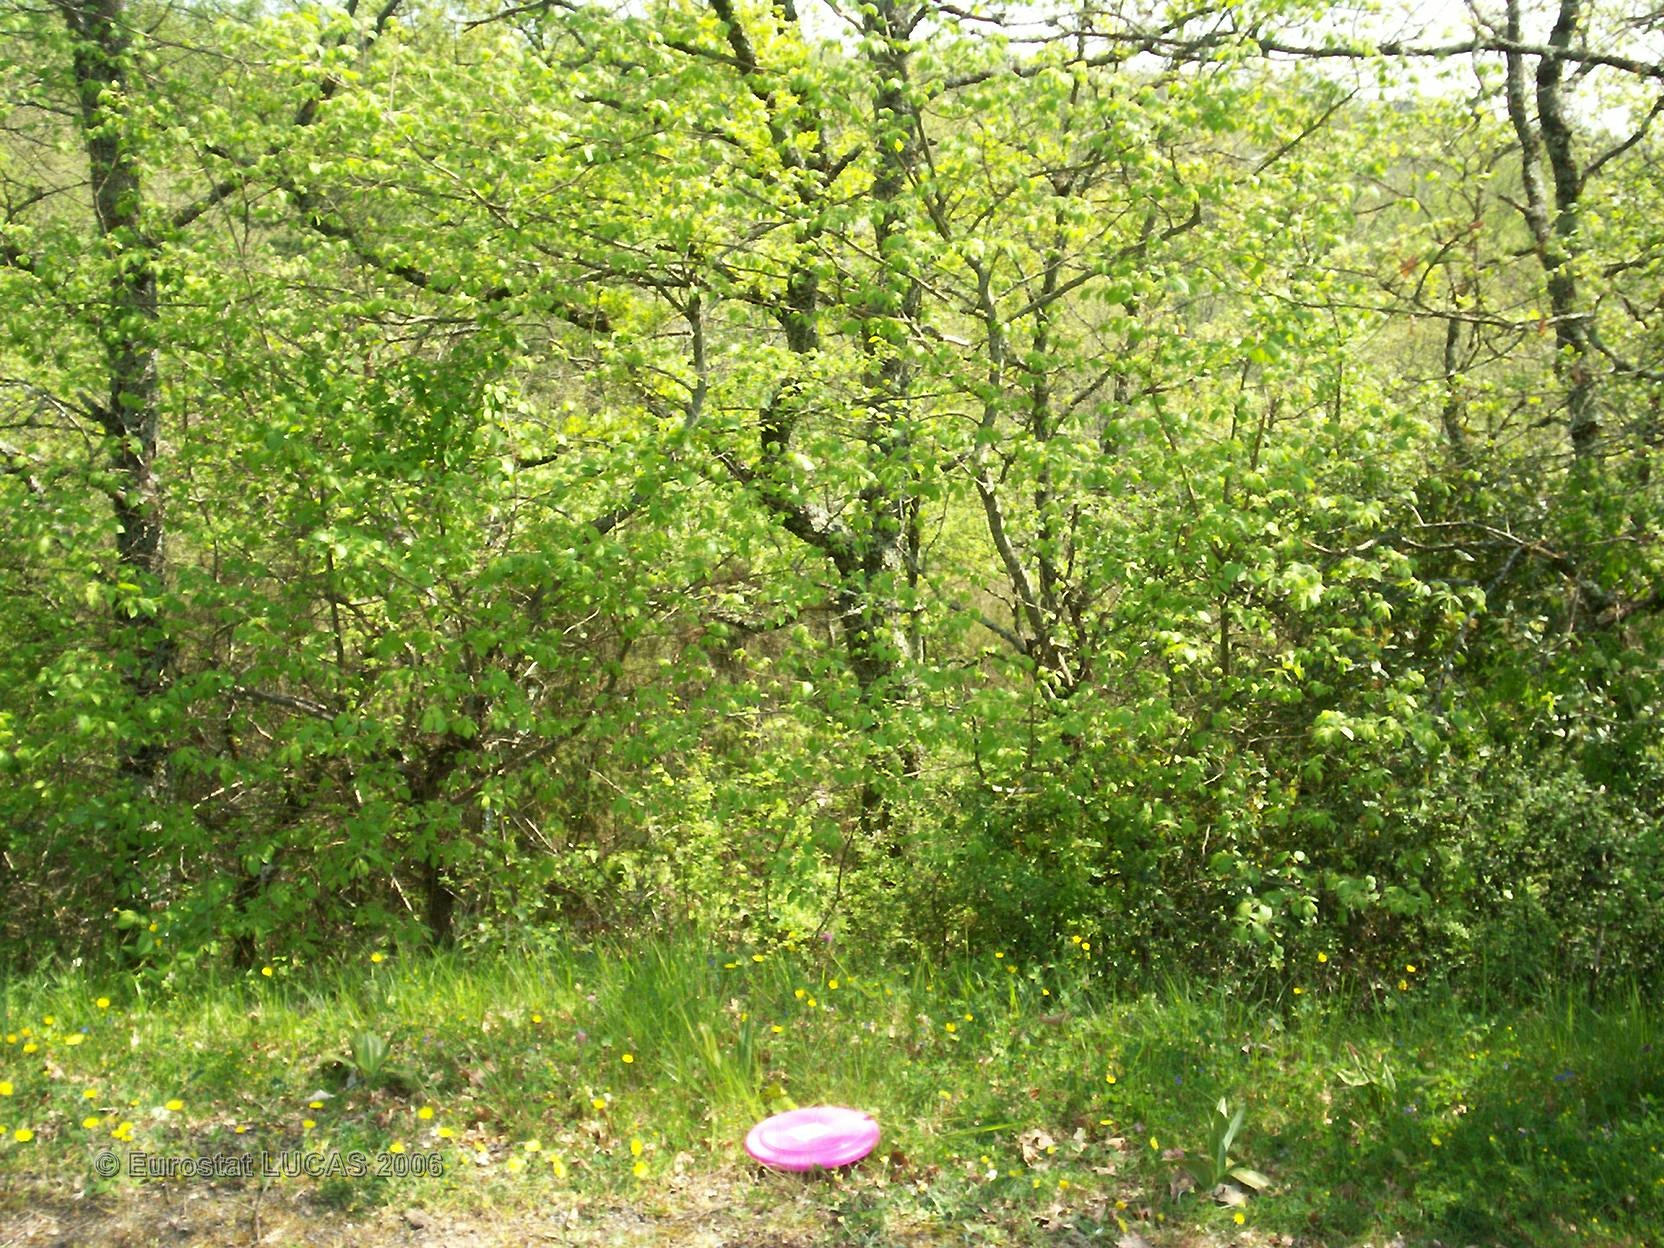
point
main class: Woodland
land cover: Broadleaved forest
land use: Forestry
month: April
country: FR
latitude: 43.6812
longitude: 2.0284
